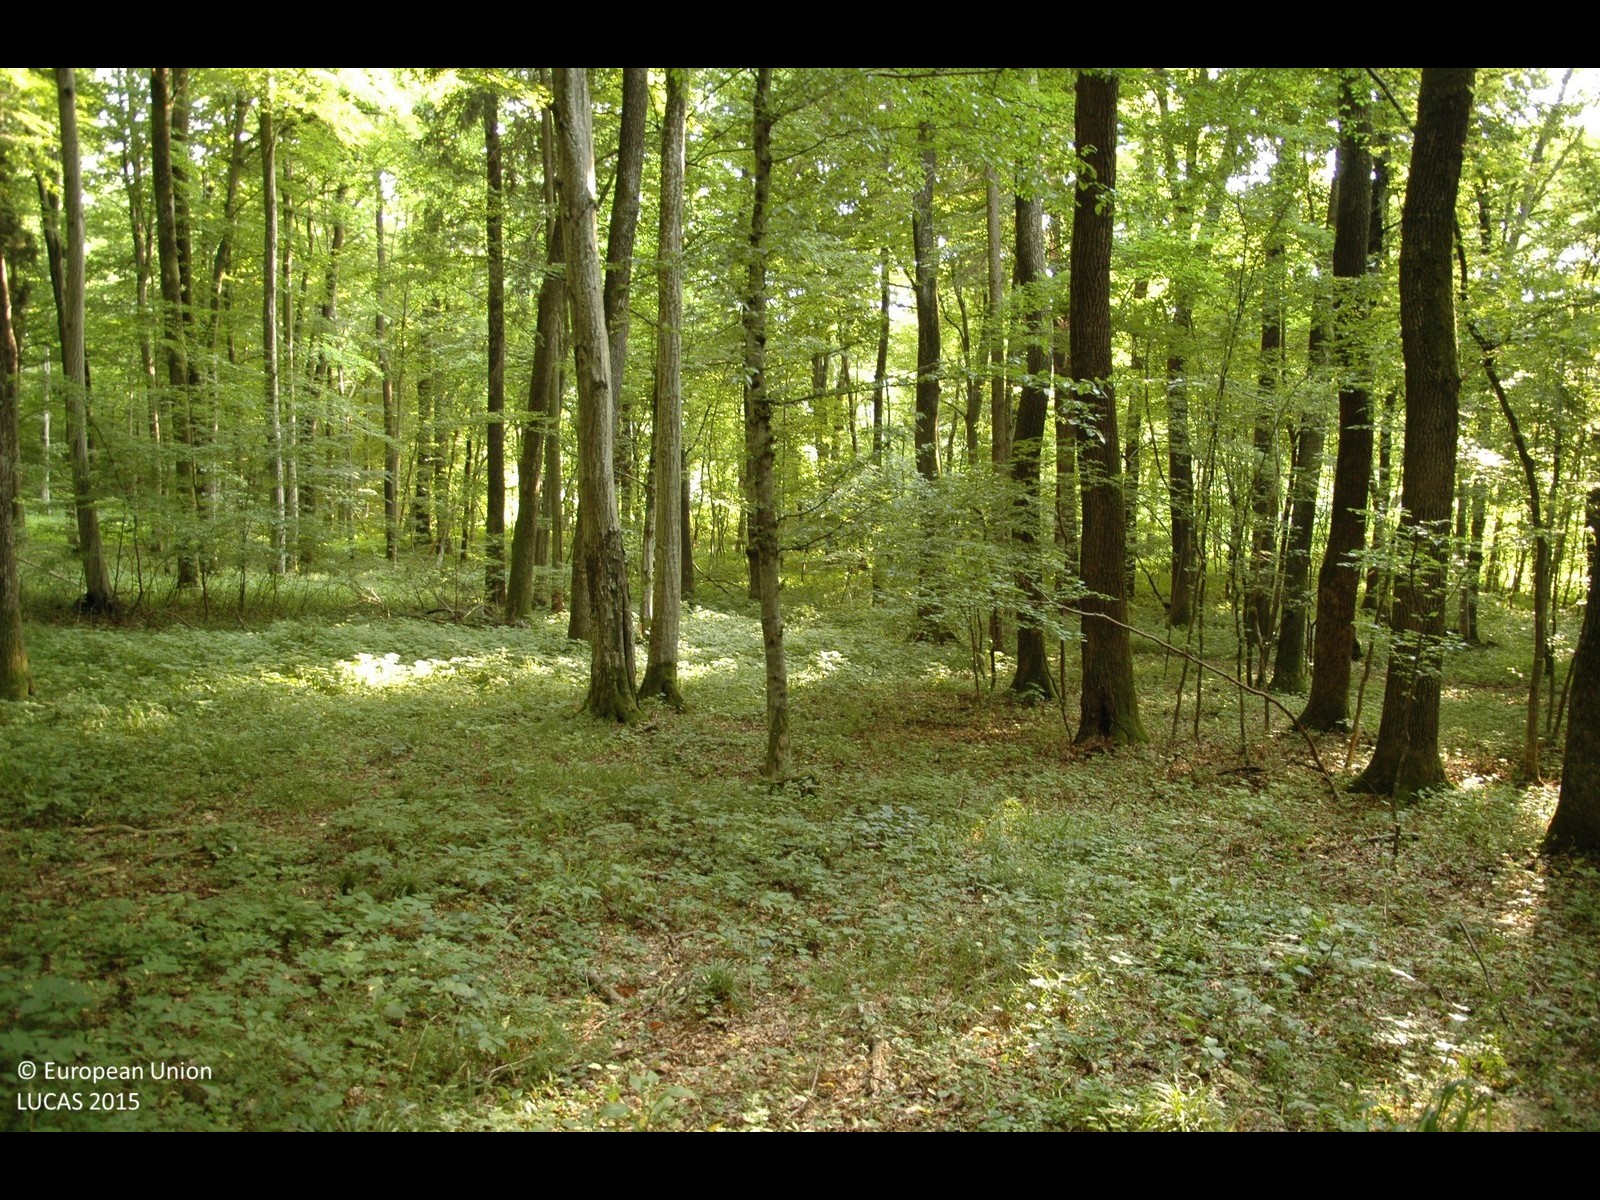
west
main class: Woodland
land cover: Broadleaved woodland
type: mesophytic deciduous forest
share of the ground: > 75 %
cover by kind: broadleaved forest trees 100 %
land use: Forestry
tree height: > 5 m
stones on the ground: < 10 %
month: June
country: HR
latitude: 46.4536
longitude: 16.3148
